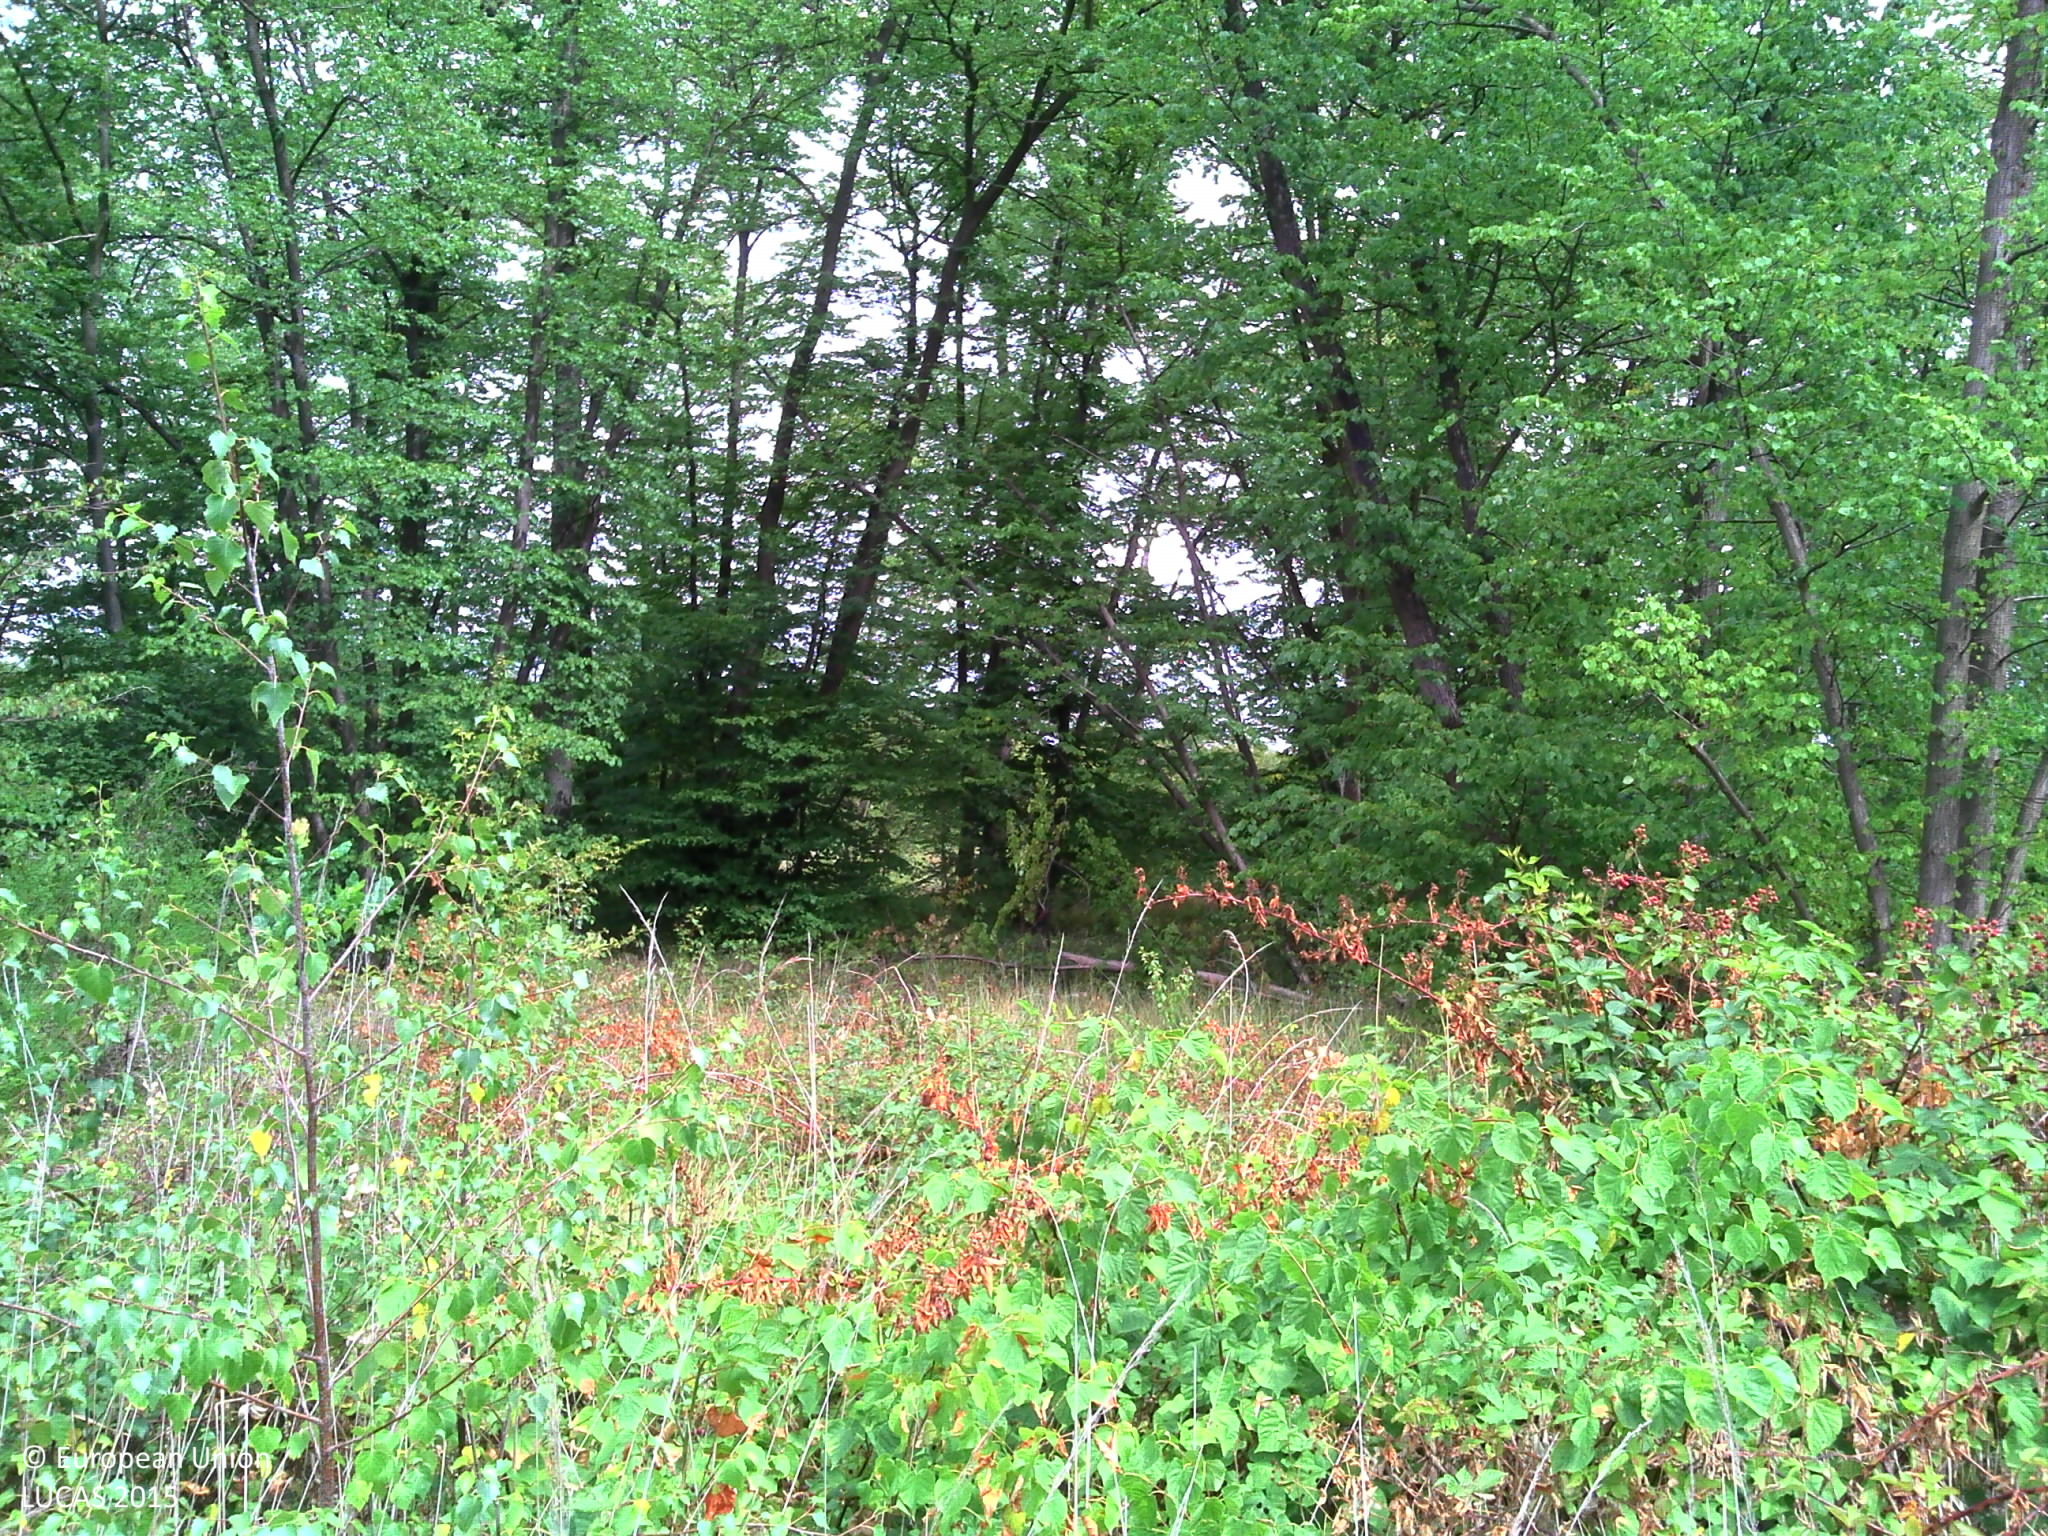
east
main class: Shrubland
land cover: Shrubland with sparse tree cover
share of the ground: > 75 %
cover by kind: shrubs 55 %, herbaceous plants 40 %, broadleaved forest trees 5 %
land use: Semi-natural and natural areas not in use
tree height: < 5 m
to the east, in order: Shrubland with sparse tree cover; Broadleaved woodland; Grassland with sparse tree/shrub cover; Fences; Broadleaved woodland
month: July
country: FR
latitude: 49.1416
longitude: 2.4901
